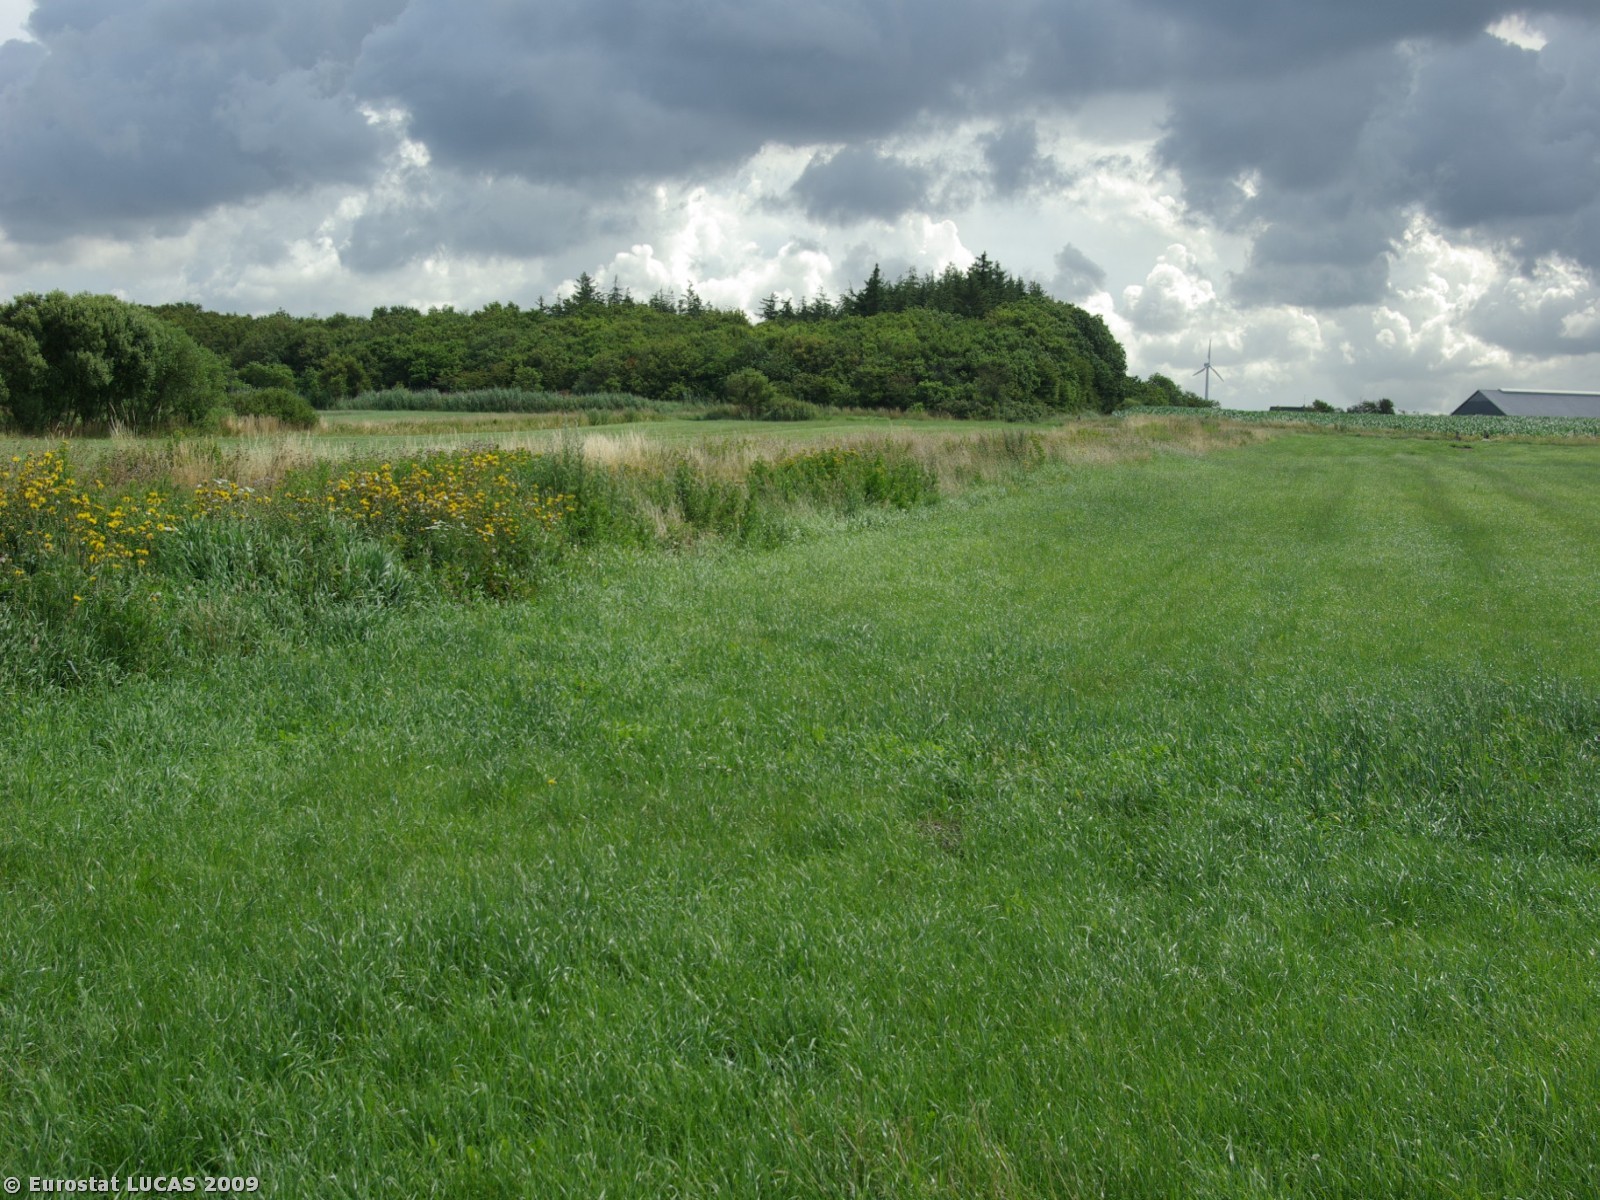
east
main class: Grassland
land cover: Grassland without tree/shrub cover
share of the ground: > 75 %
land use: Agriculture (excluding fallow land and kitchen gardens)
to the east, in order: Grassland without tree/shrub cover; Spontaneously vegetated surfaces; Tracks; Spontaneously vegetated surfaces; Ditches and canals; Shruby margins; Grassland without tree/shrub cover; Abandoned hedges; Tracks; Spontaneously vegetated surfaces; Rivers and streams; Managed hedges; Broadleaved woodland; Coniferous woodland
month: July
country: DK
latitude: 54.9771
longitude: 8.7354
